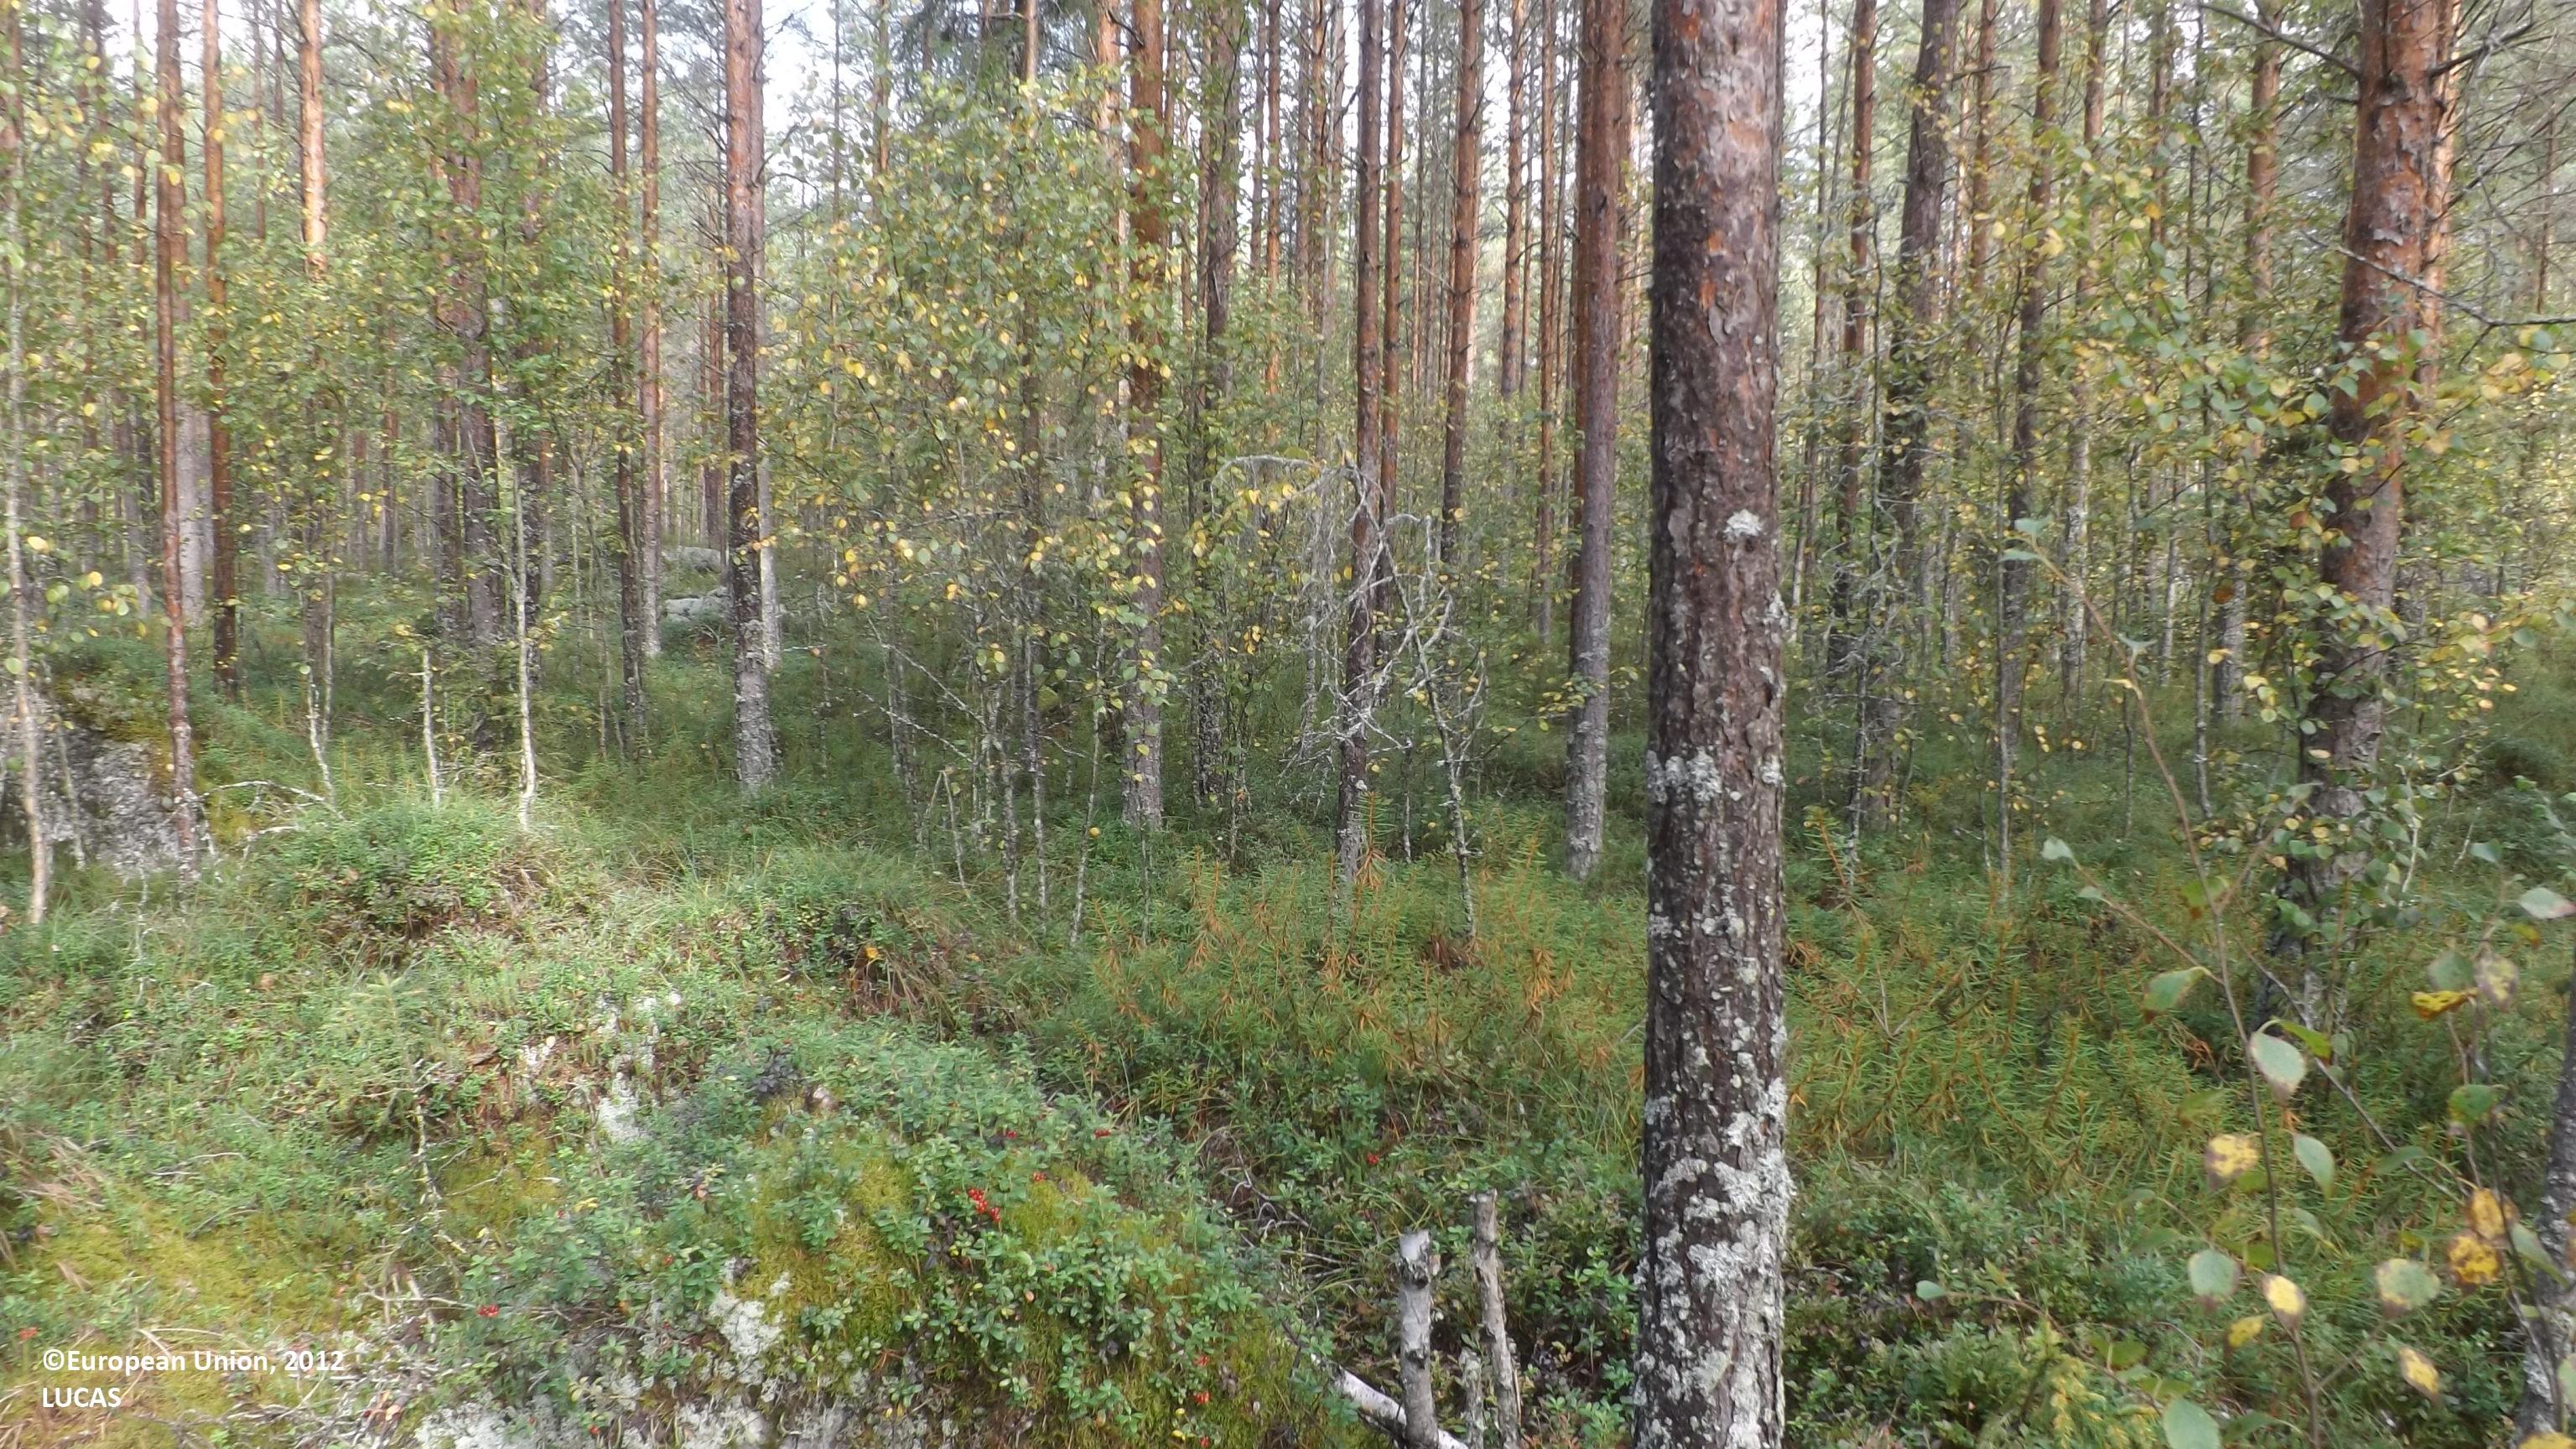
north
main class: Woodland
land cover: Pine dominated coniferous woodland
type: boreal forest
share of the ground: 50 - 75 %
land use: Forestry
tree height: > 5 m
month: August
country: FI
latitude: 63.8510
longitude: 23.5431
